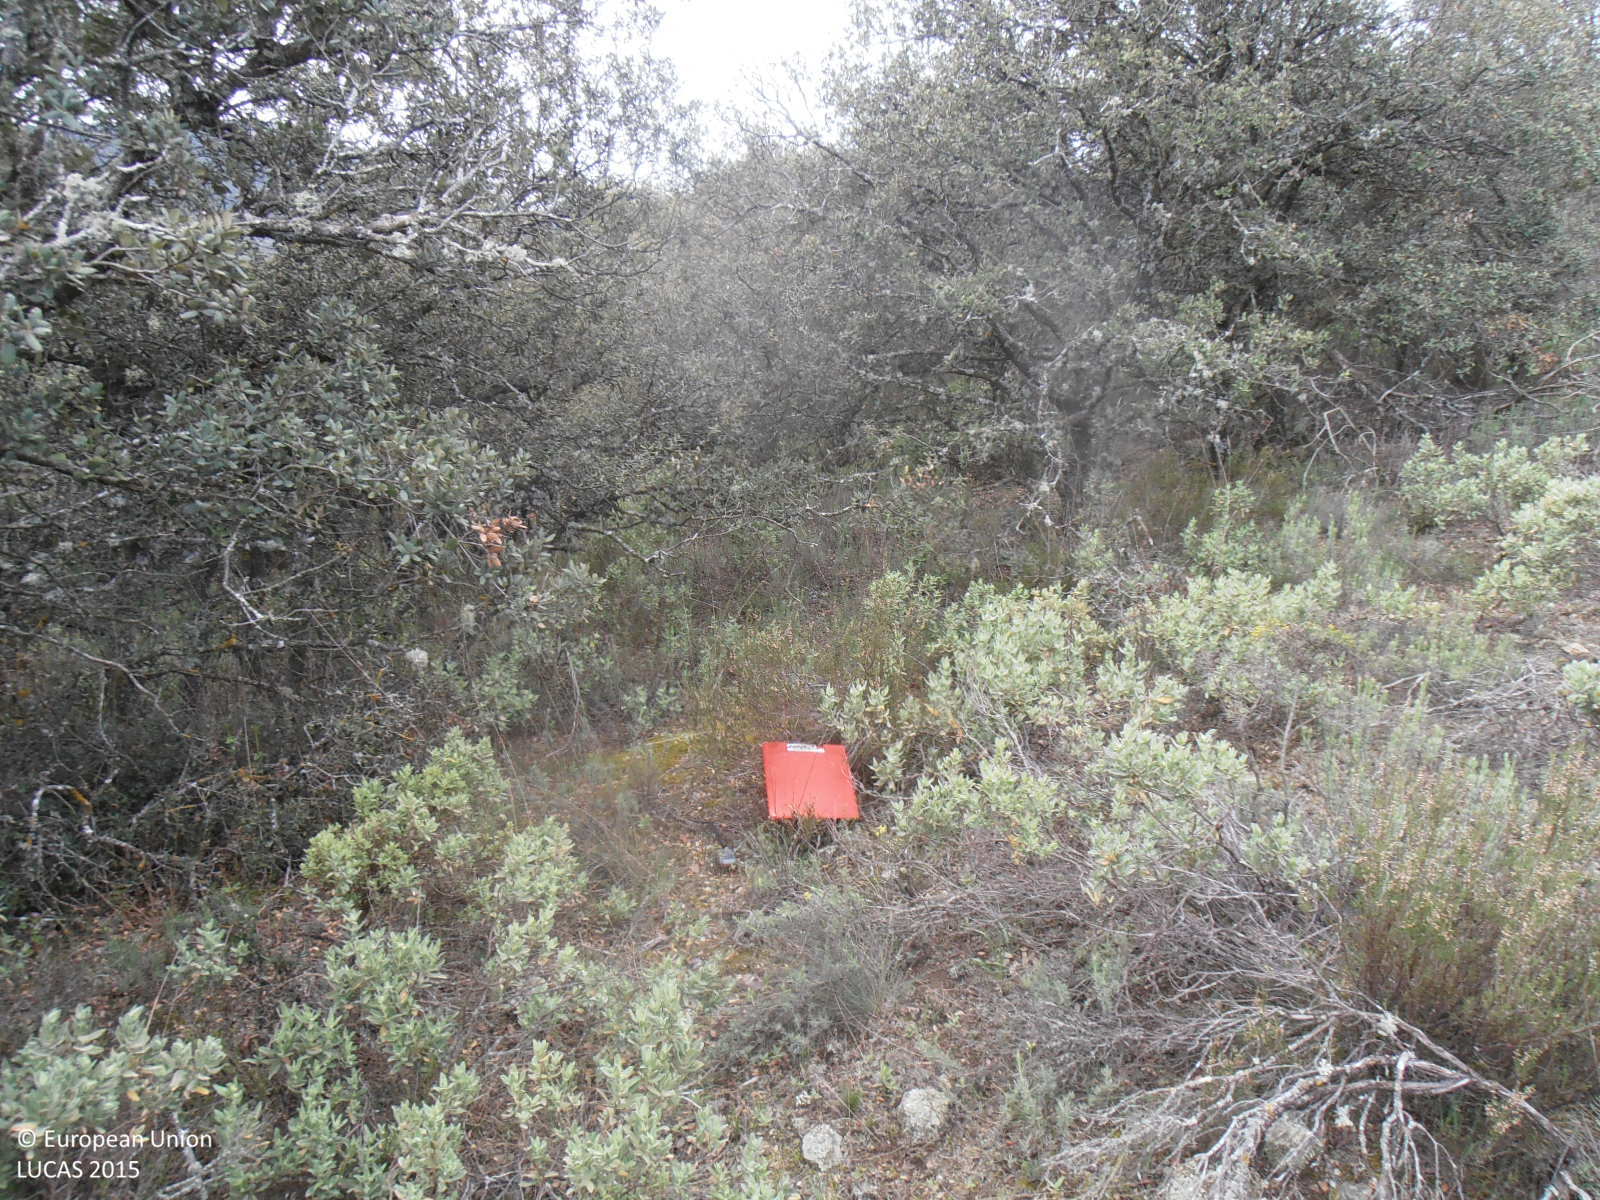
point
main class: Woodland
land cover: Broadleaved woodland
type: thermophilous deciduous forest
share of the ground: > 75 %
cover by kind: broadleaved forest trees 80 %, shrubs 20 %
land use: Semi-natural and natural areas not in use
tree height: < 5 m
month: April
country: ES
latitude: 41.2015
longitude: -1.1214
